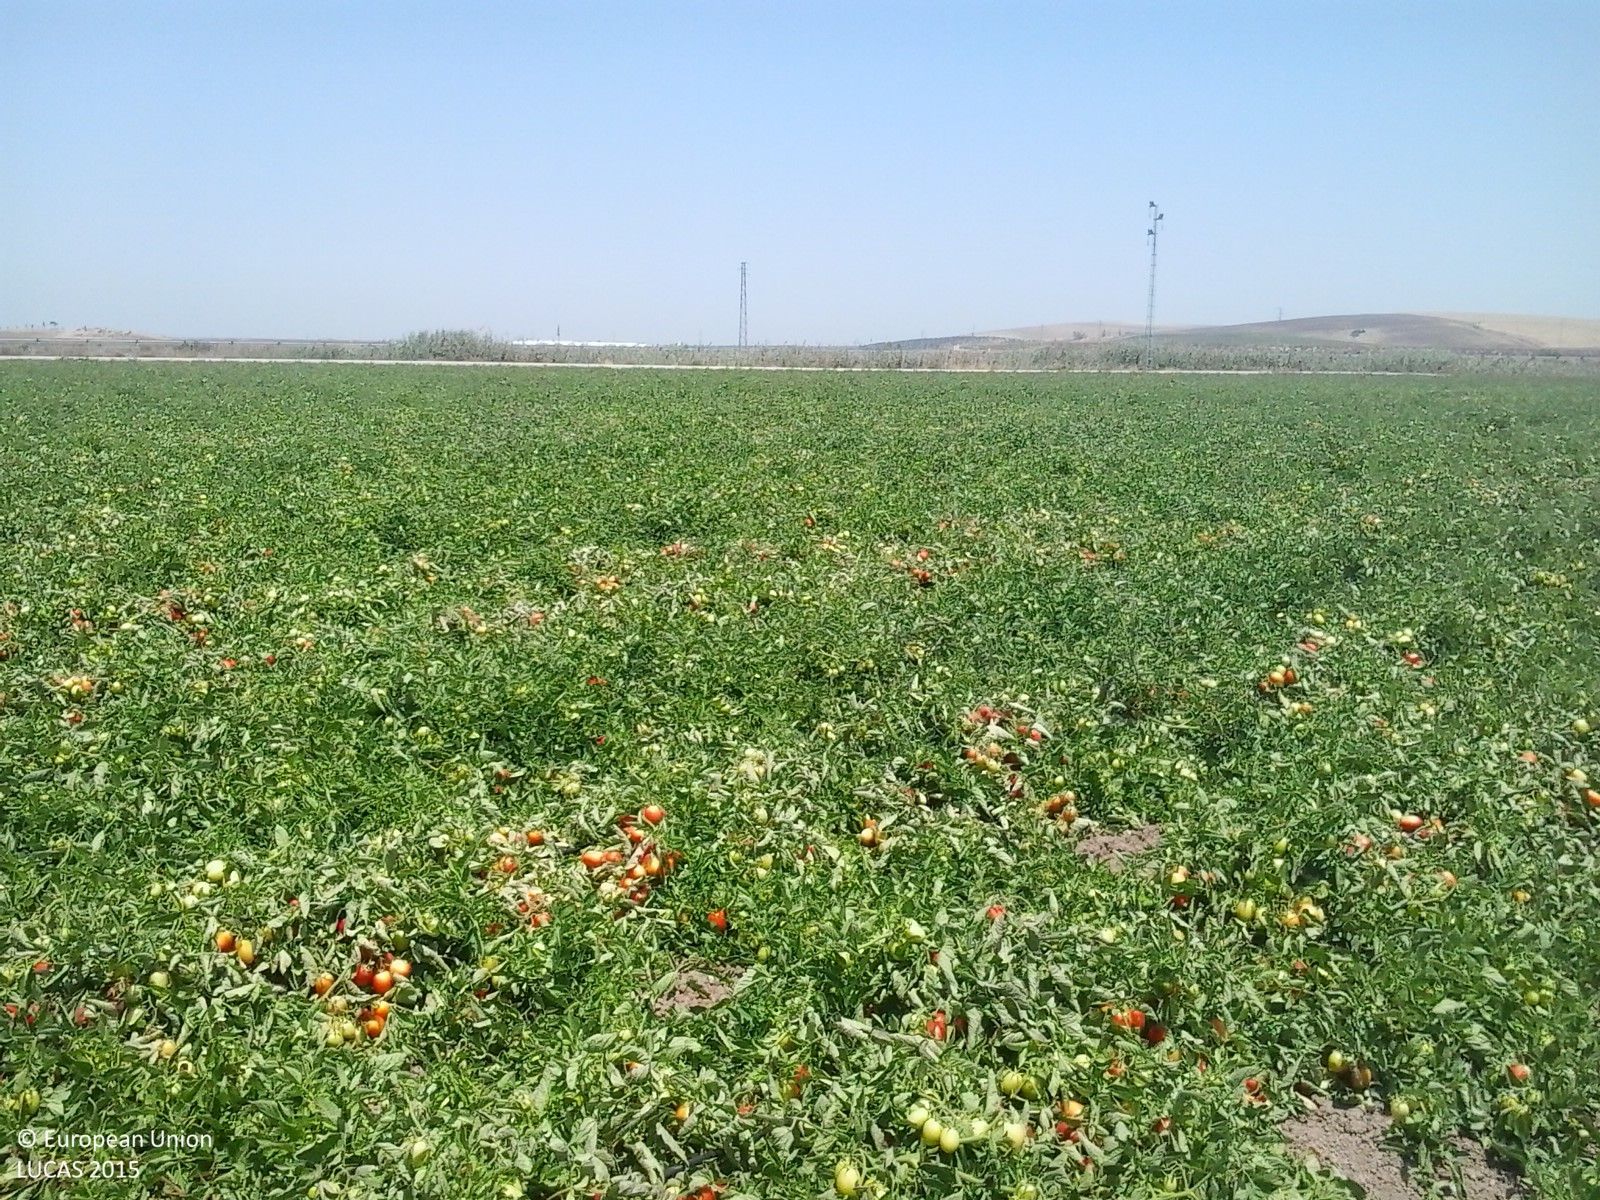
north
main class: Cropland
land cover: Tomatoes
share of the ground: > 75 %
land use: Agriculture (excluding fallow land and kitchen gardens)
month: July
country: ES
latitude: 36.9556
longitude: -5.9964
